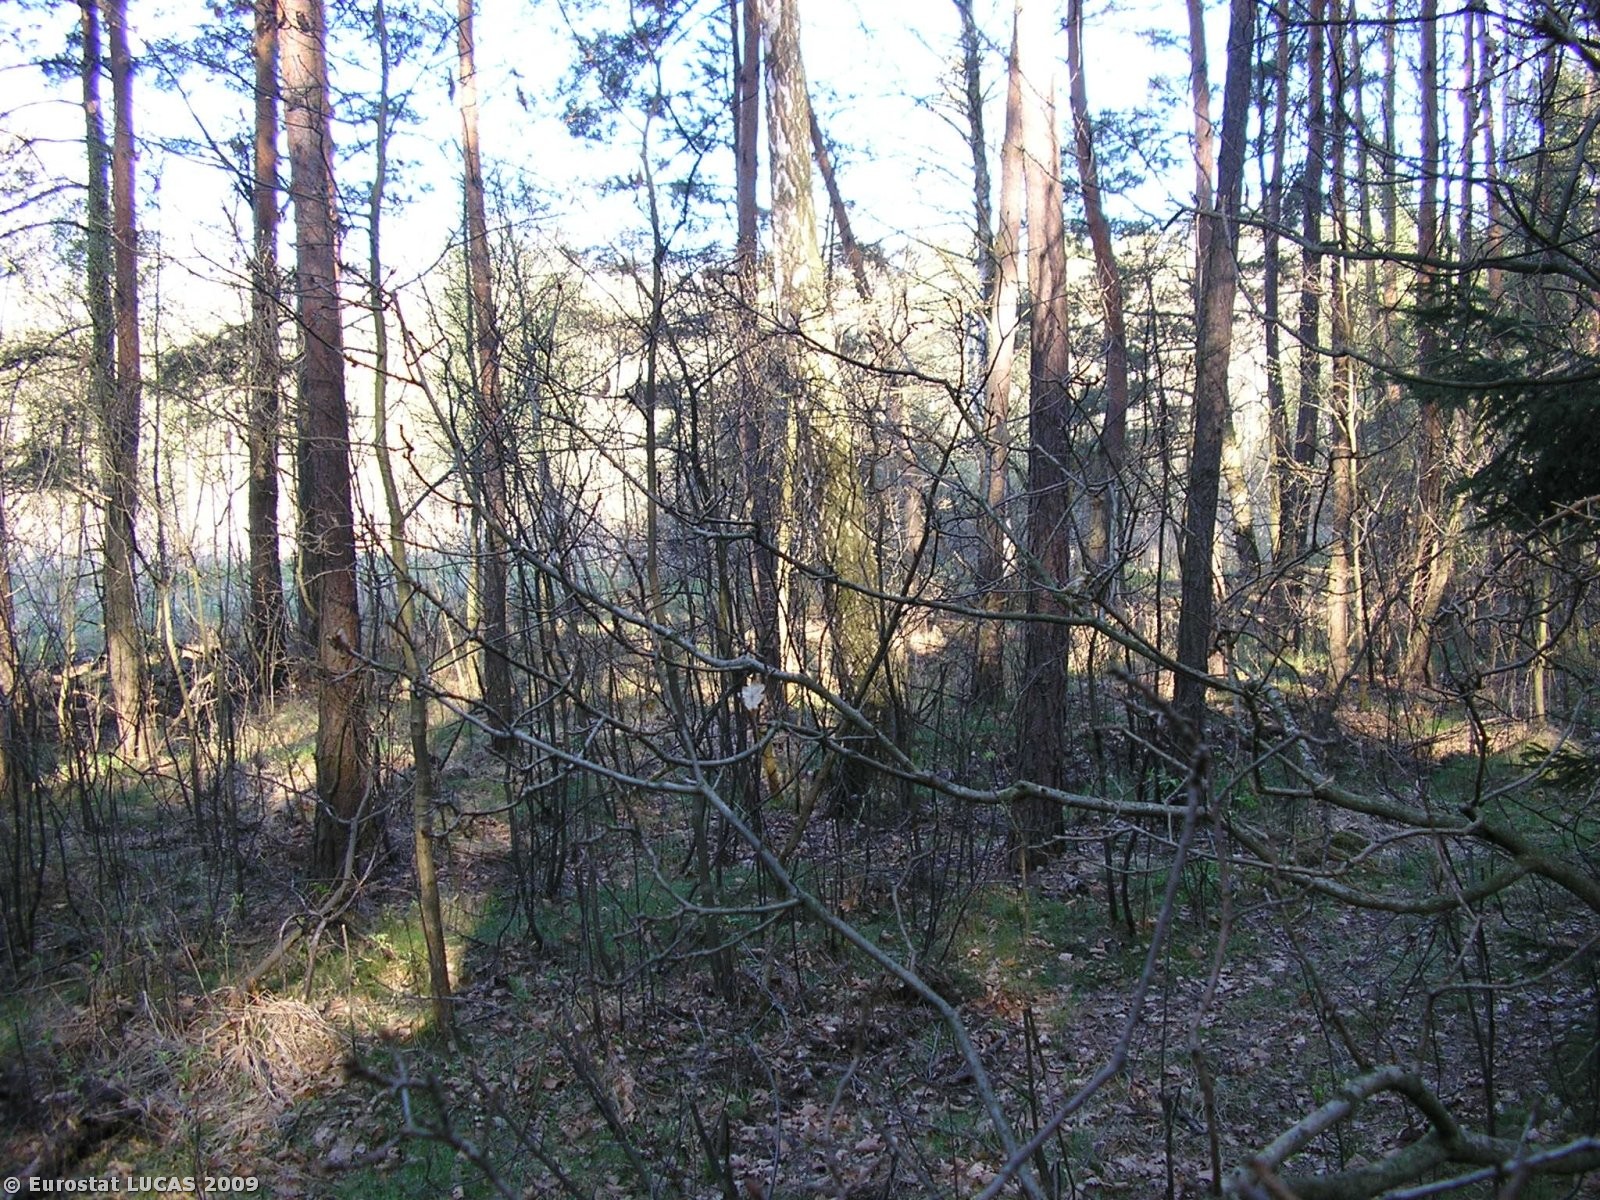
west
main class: Woodland
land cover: Coniferous woodland
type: hemiboreal forest and nemoral coniferous forest and mixed broadleaved-coniferous forest
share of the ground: > 75 %
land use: Forestry
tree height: > 5 m
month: April
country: PL
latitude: 52.0509
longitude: 20.1398
